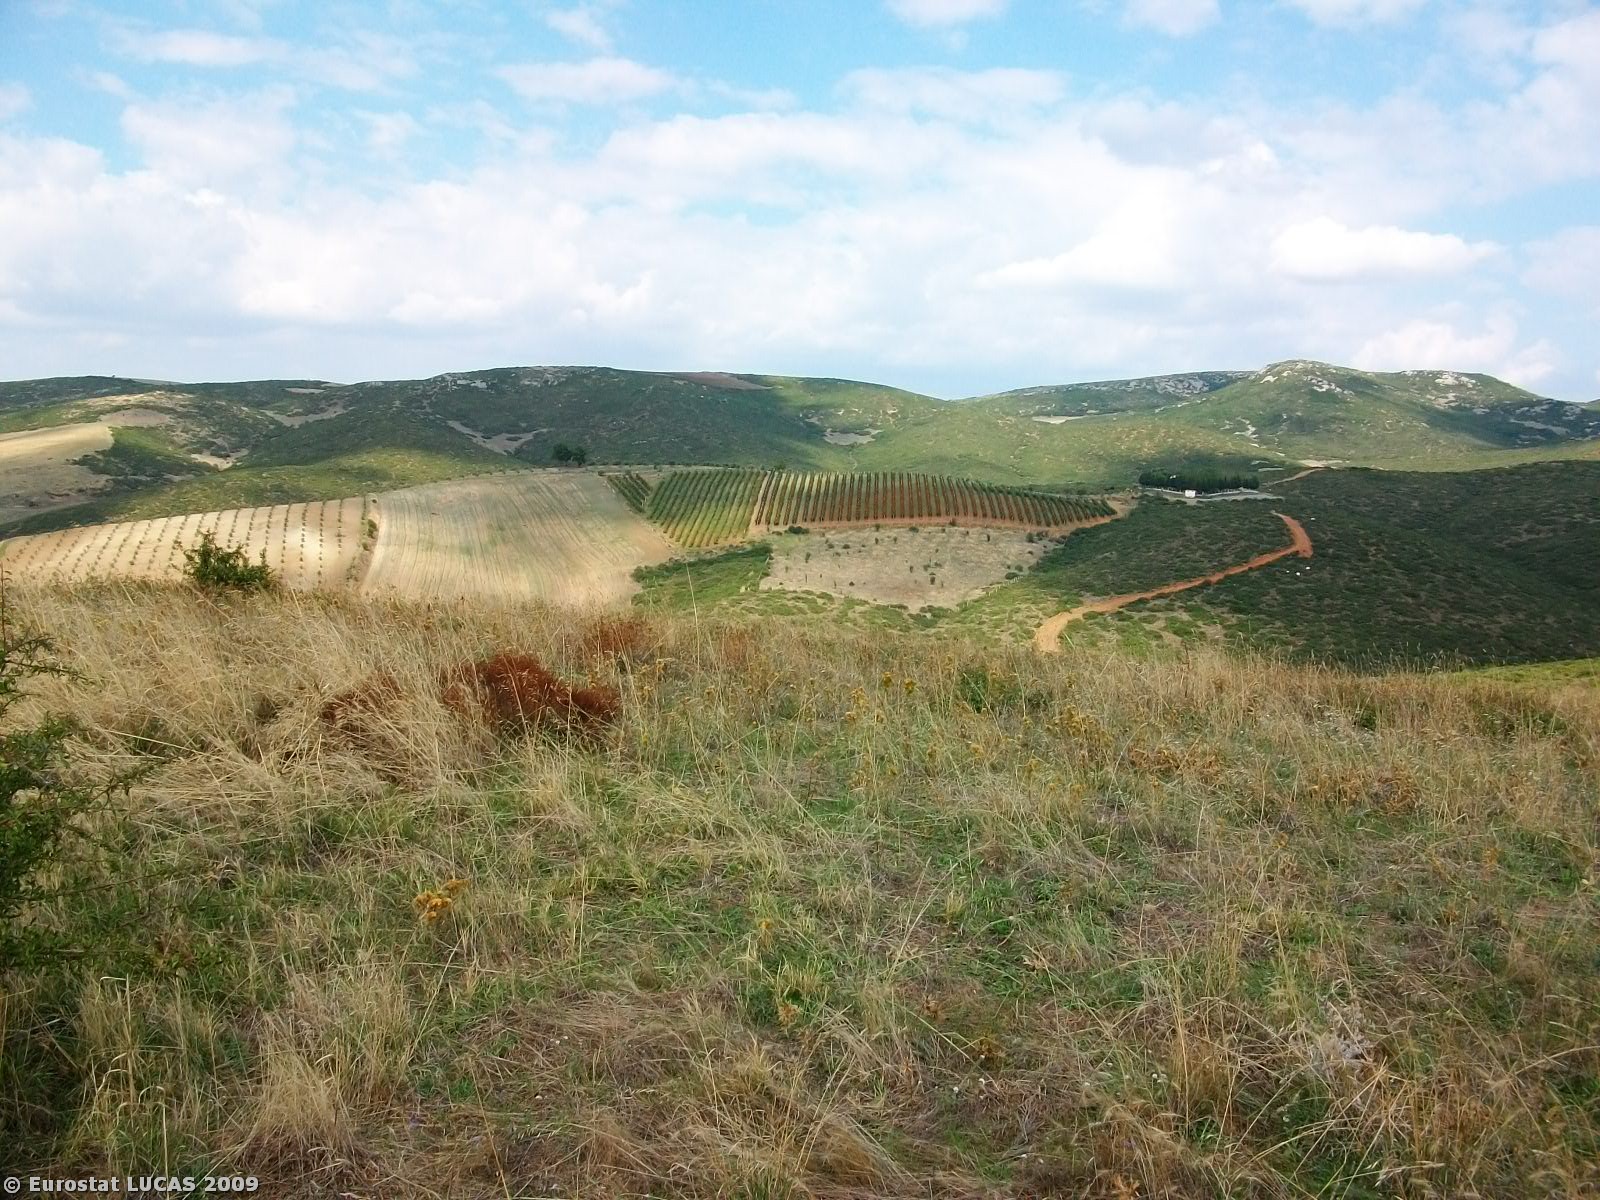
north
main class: Grassland
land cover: Grassland without tree/shrub cover
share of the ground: > 75 %
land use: Agriculture (excluding fallow land and kitchen gardens)
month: September
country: GR
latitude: 39.4042
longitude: 22.5417
